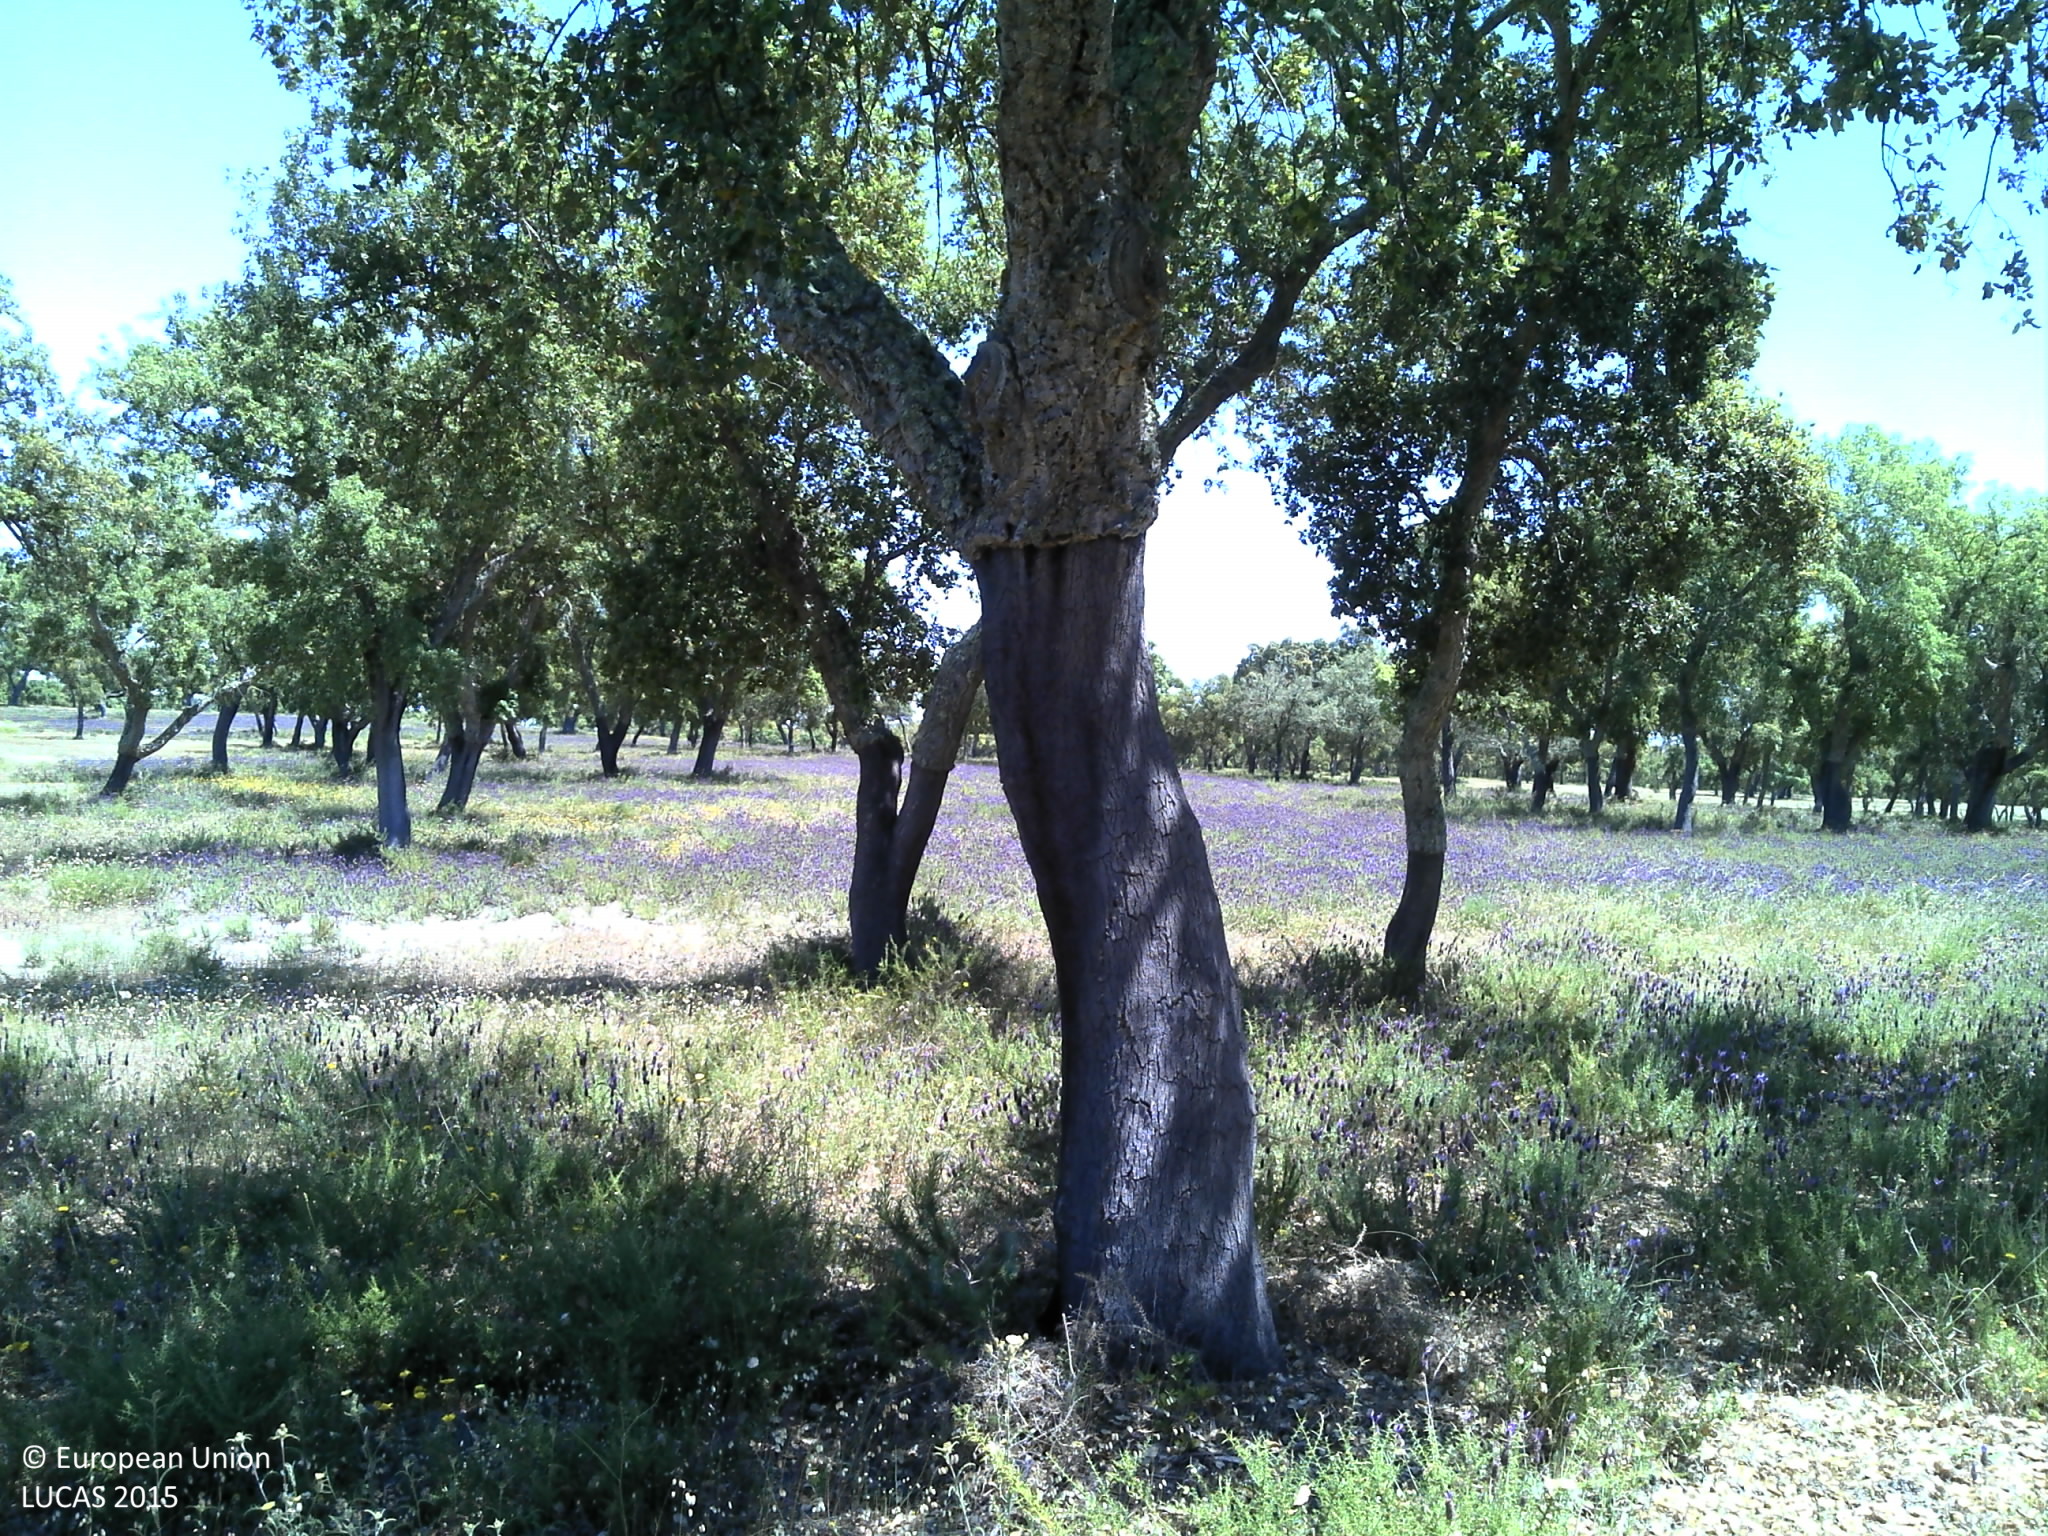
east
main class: Woodland
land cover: Broadleaved woodland
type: broadleaved evergreen forest
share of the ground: 25 - 50 %
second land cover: Grassland without tree/shrub cover
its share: 25 - 50 %
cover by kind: broadleaved forest trees 50 %, herbaceous plants 40 %, unconsolidated bare surface 10 %
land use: Forestry
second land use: Agriculture (excluding fallow land and kitchen gardens)
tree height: > 5 m
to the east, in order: Broadleaved woodland; Grassland without tree/shrub cover; Broadleaved woodland; Grassland without tree/shrub cover
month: May
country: PT
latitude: 39.1941
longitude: -7.9169
